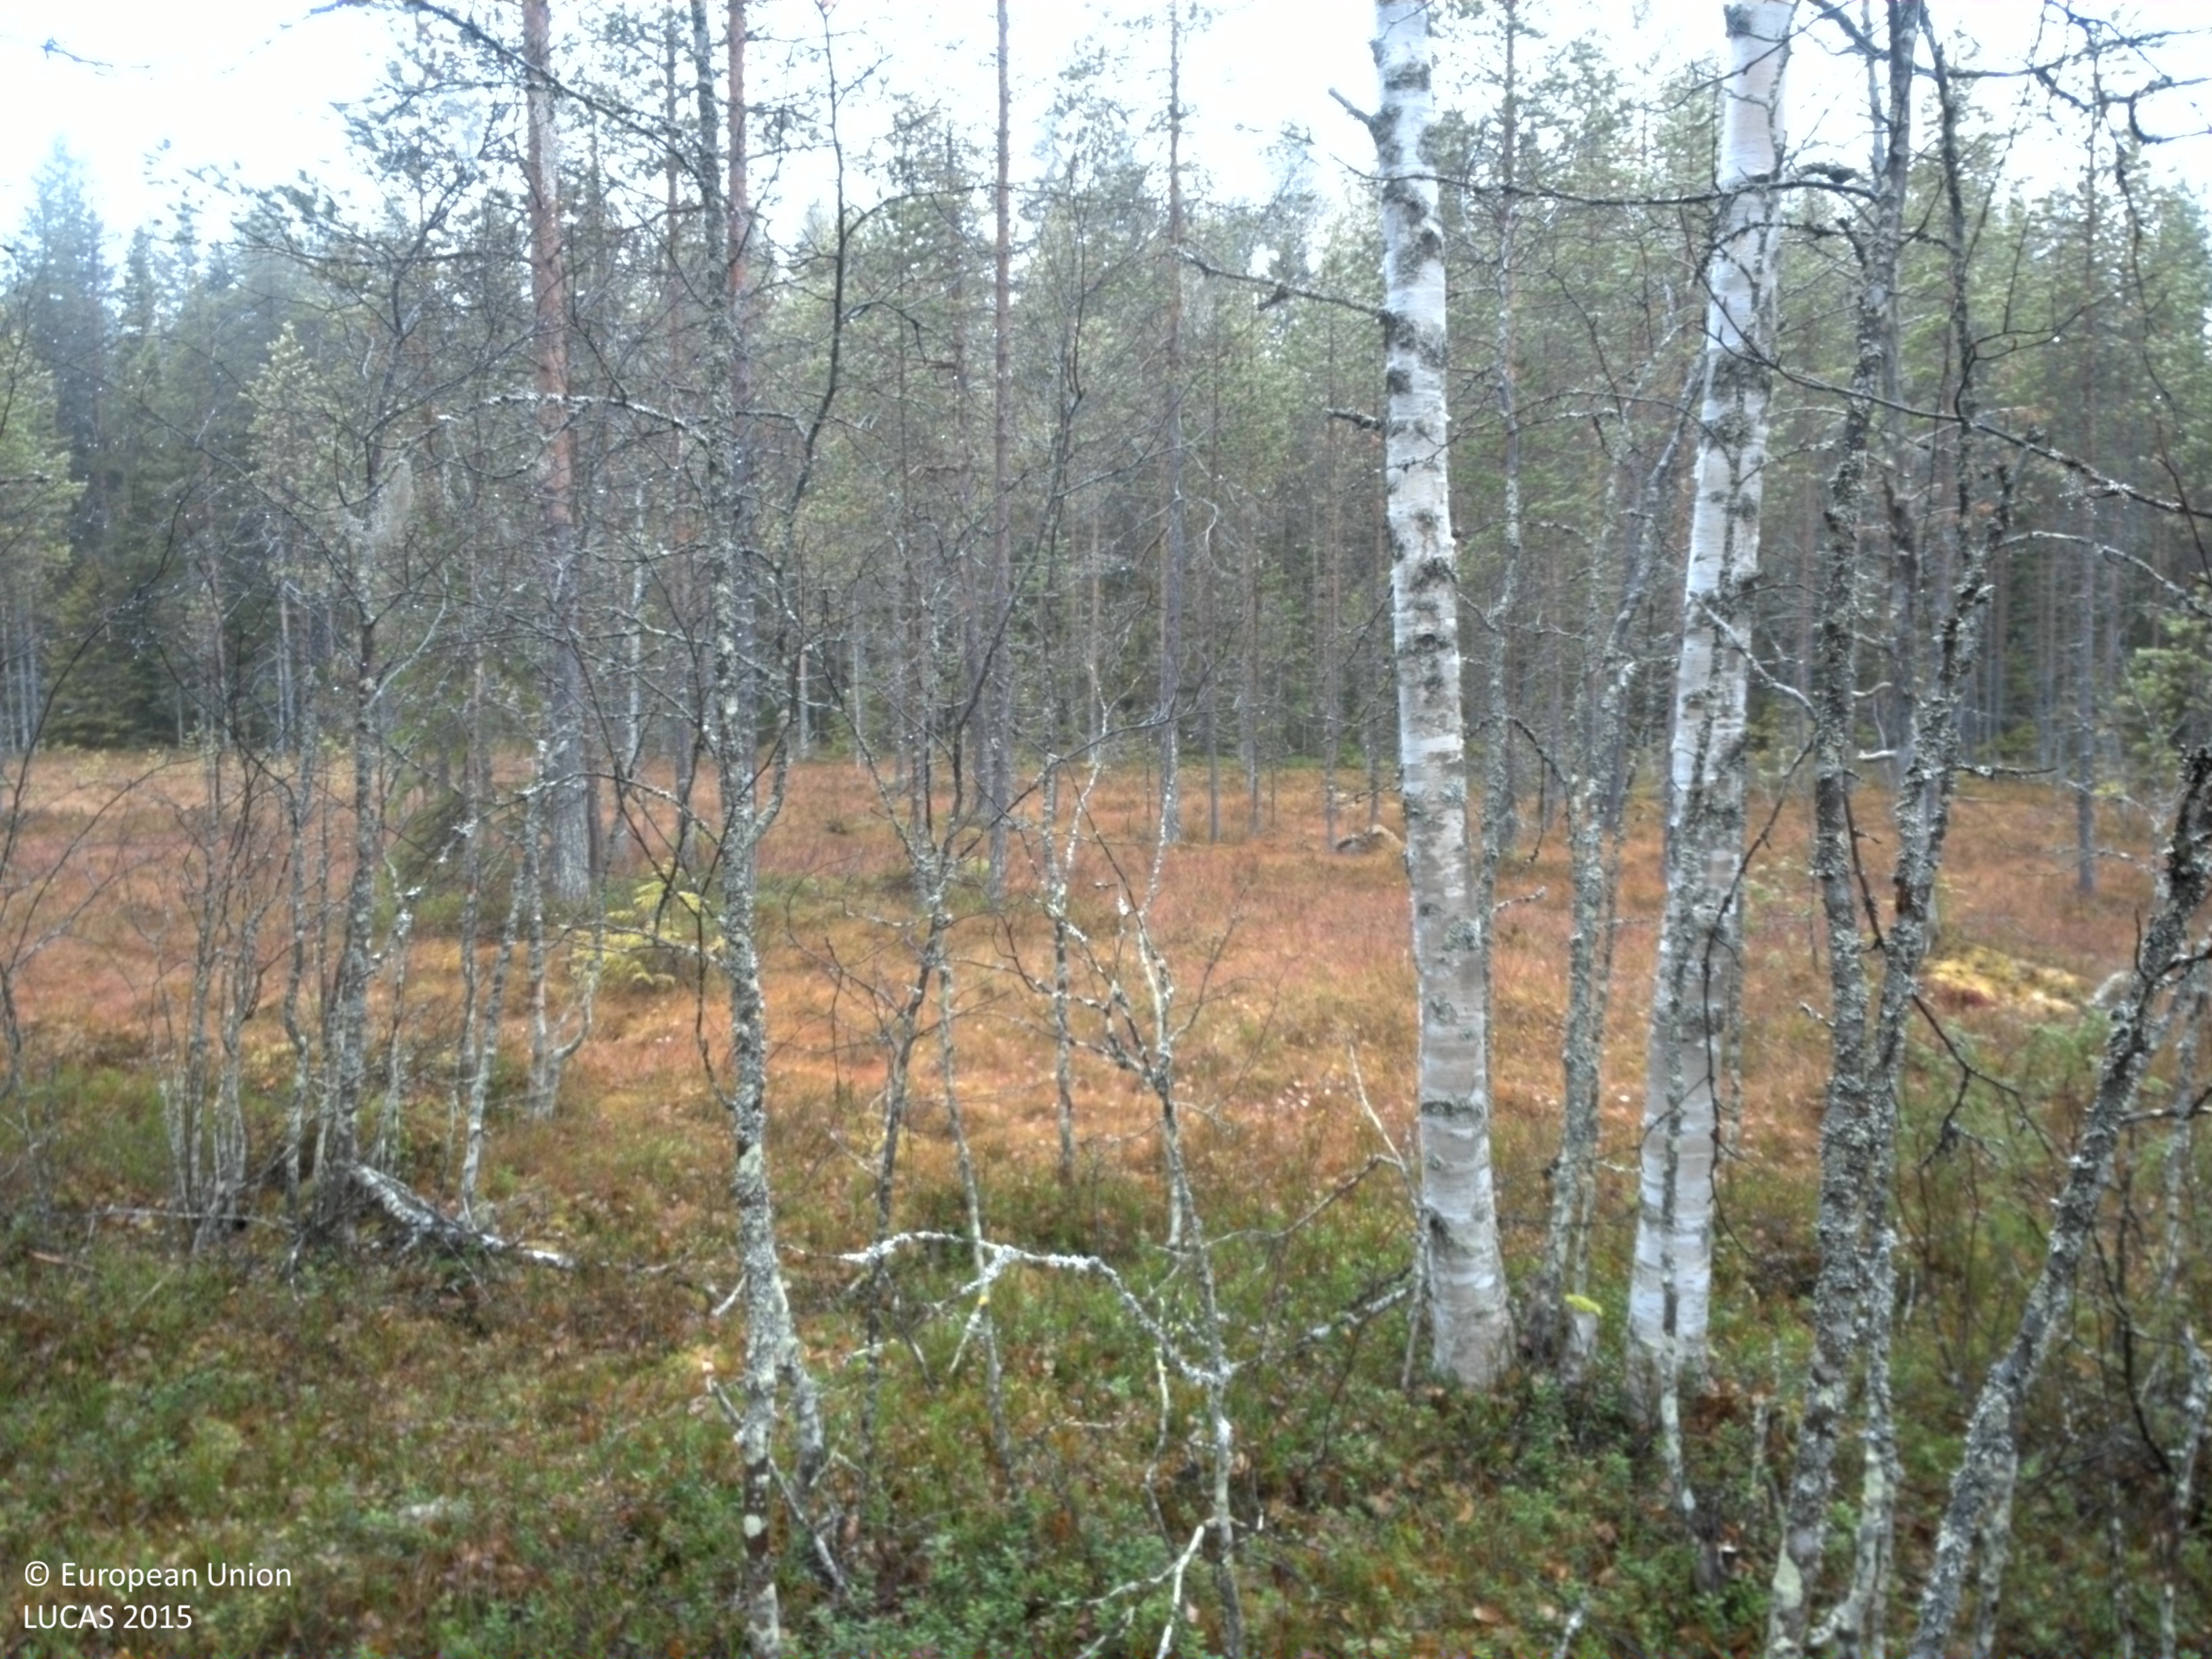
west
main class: Woodland
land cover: Pine dominated mixed woodland
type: boreal forest
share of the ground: 25 - 50 %
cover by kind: shrubs 35 %, coniferous forest trees 25 %, lichens and mosses 20 %, broadleaved forest trees 15 %, herbaceous plants 5 %
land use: Forestry
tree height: > 5 m
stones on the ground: < 10 %
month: October
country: SE
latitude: 64.4713
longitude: 16.7682
